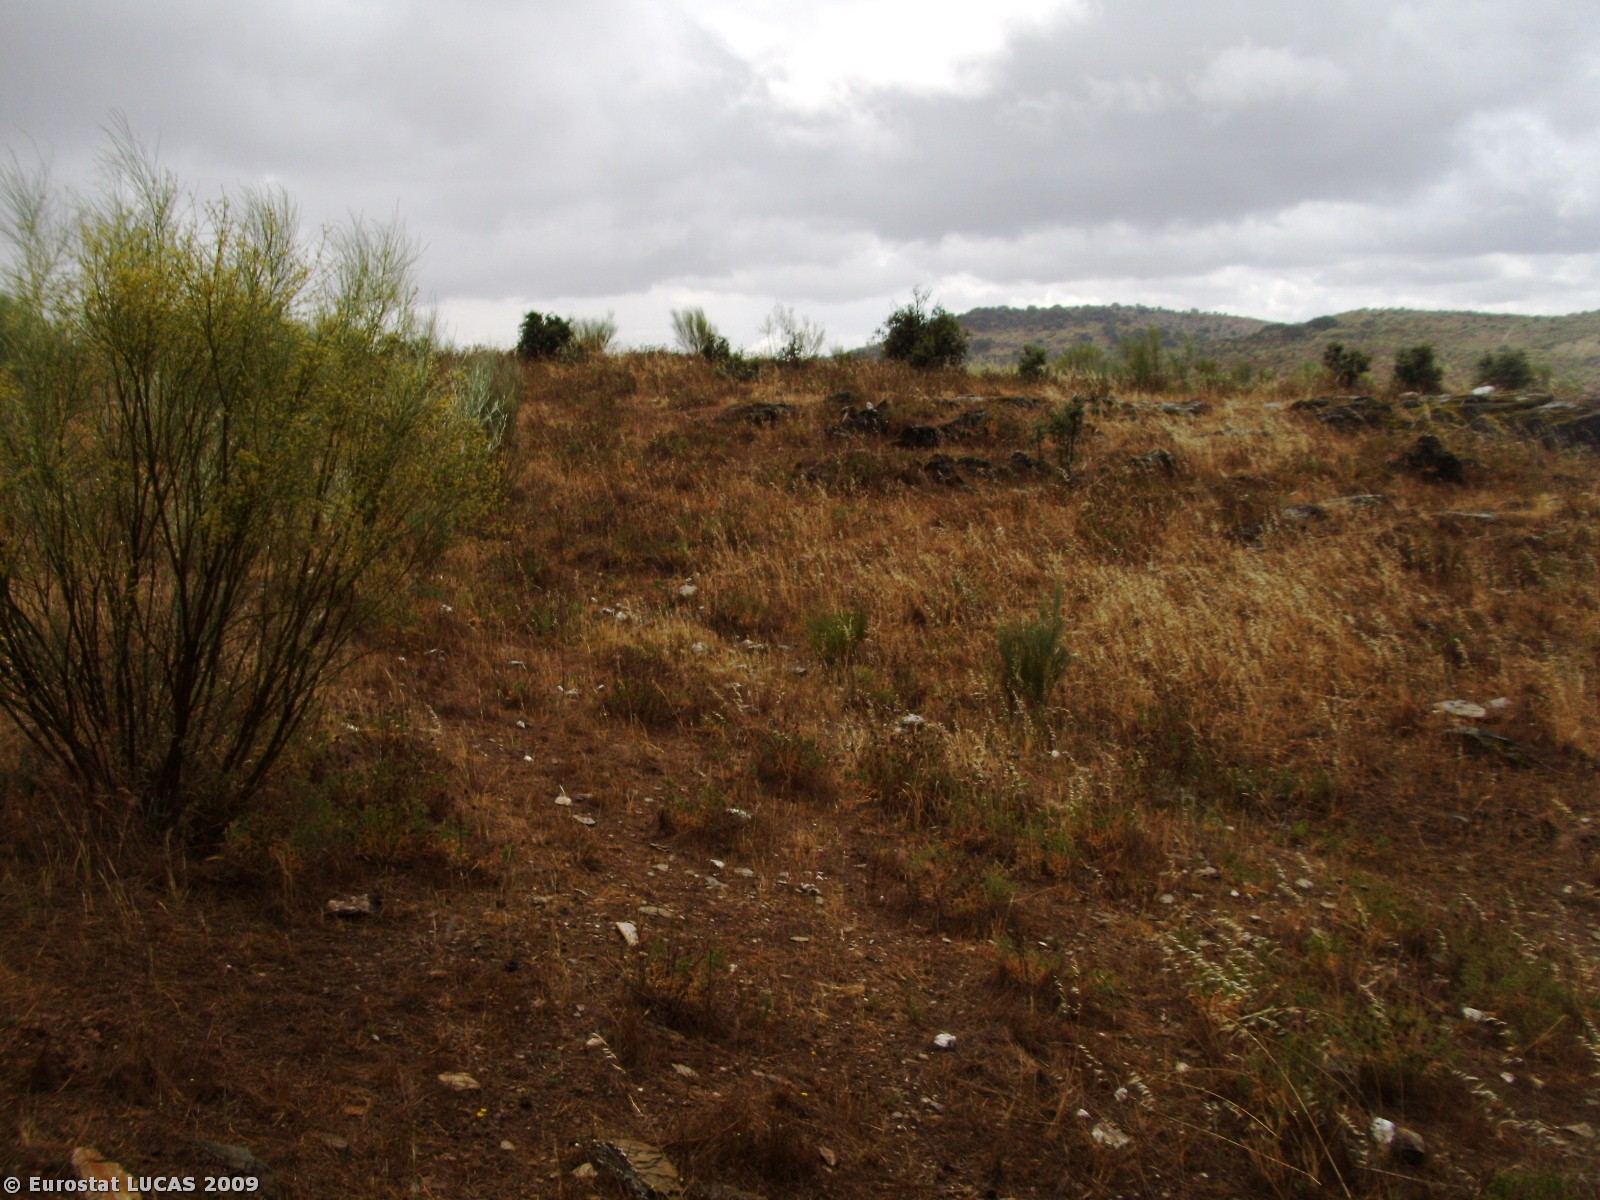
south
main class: Shrubland
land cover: Shrubland without tree cover
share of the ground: > 75 %
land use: Unused
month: June
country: PT
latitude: 39.7385
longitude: -7.1612
